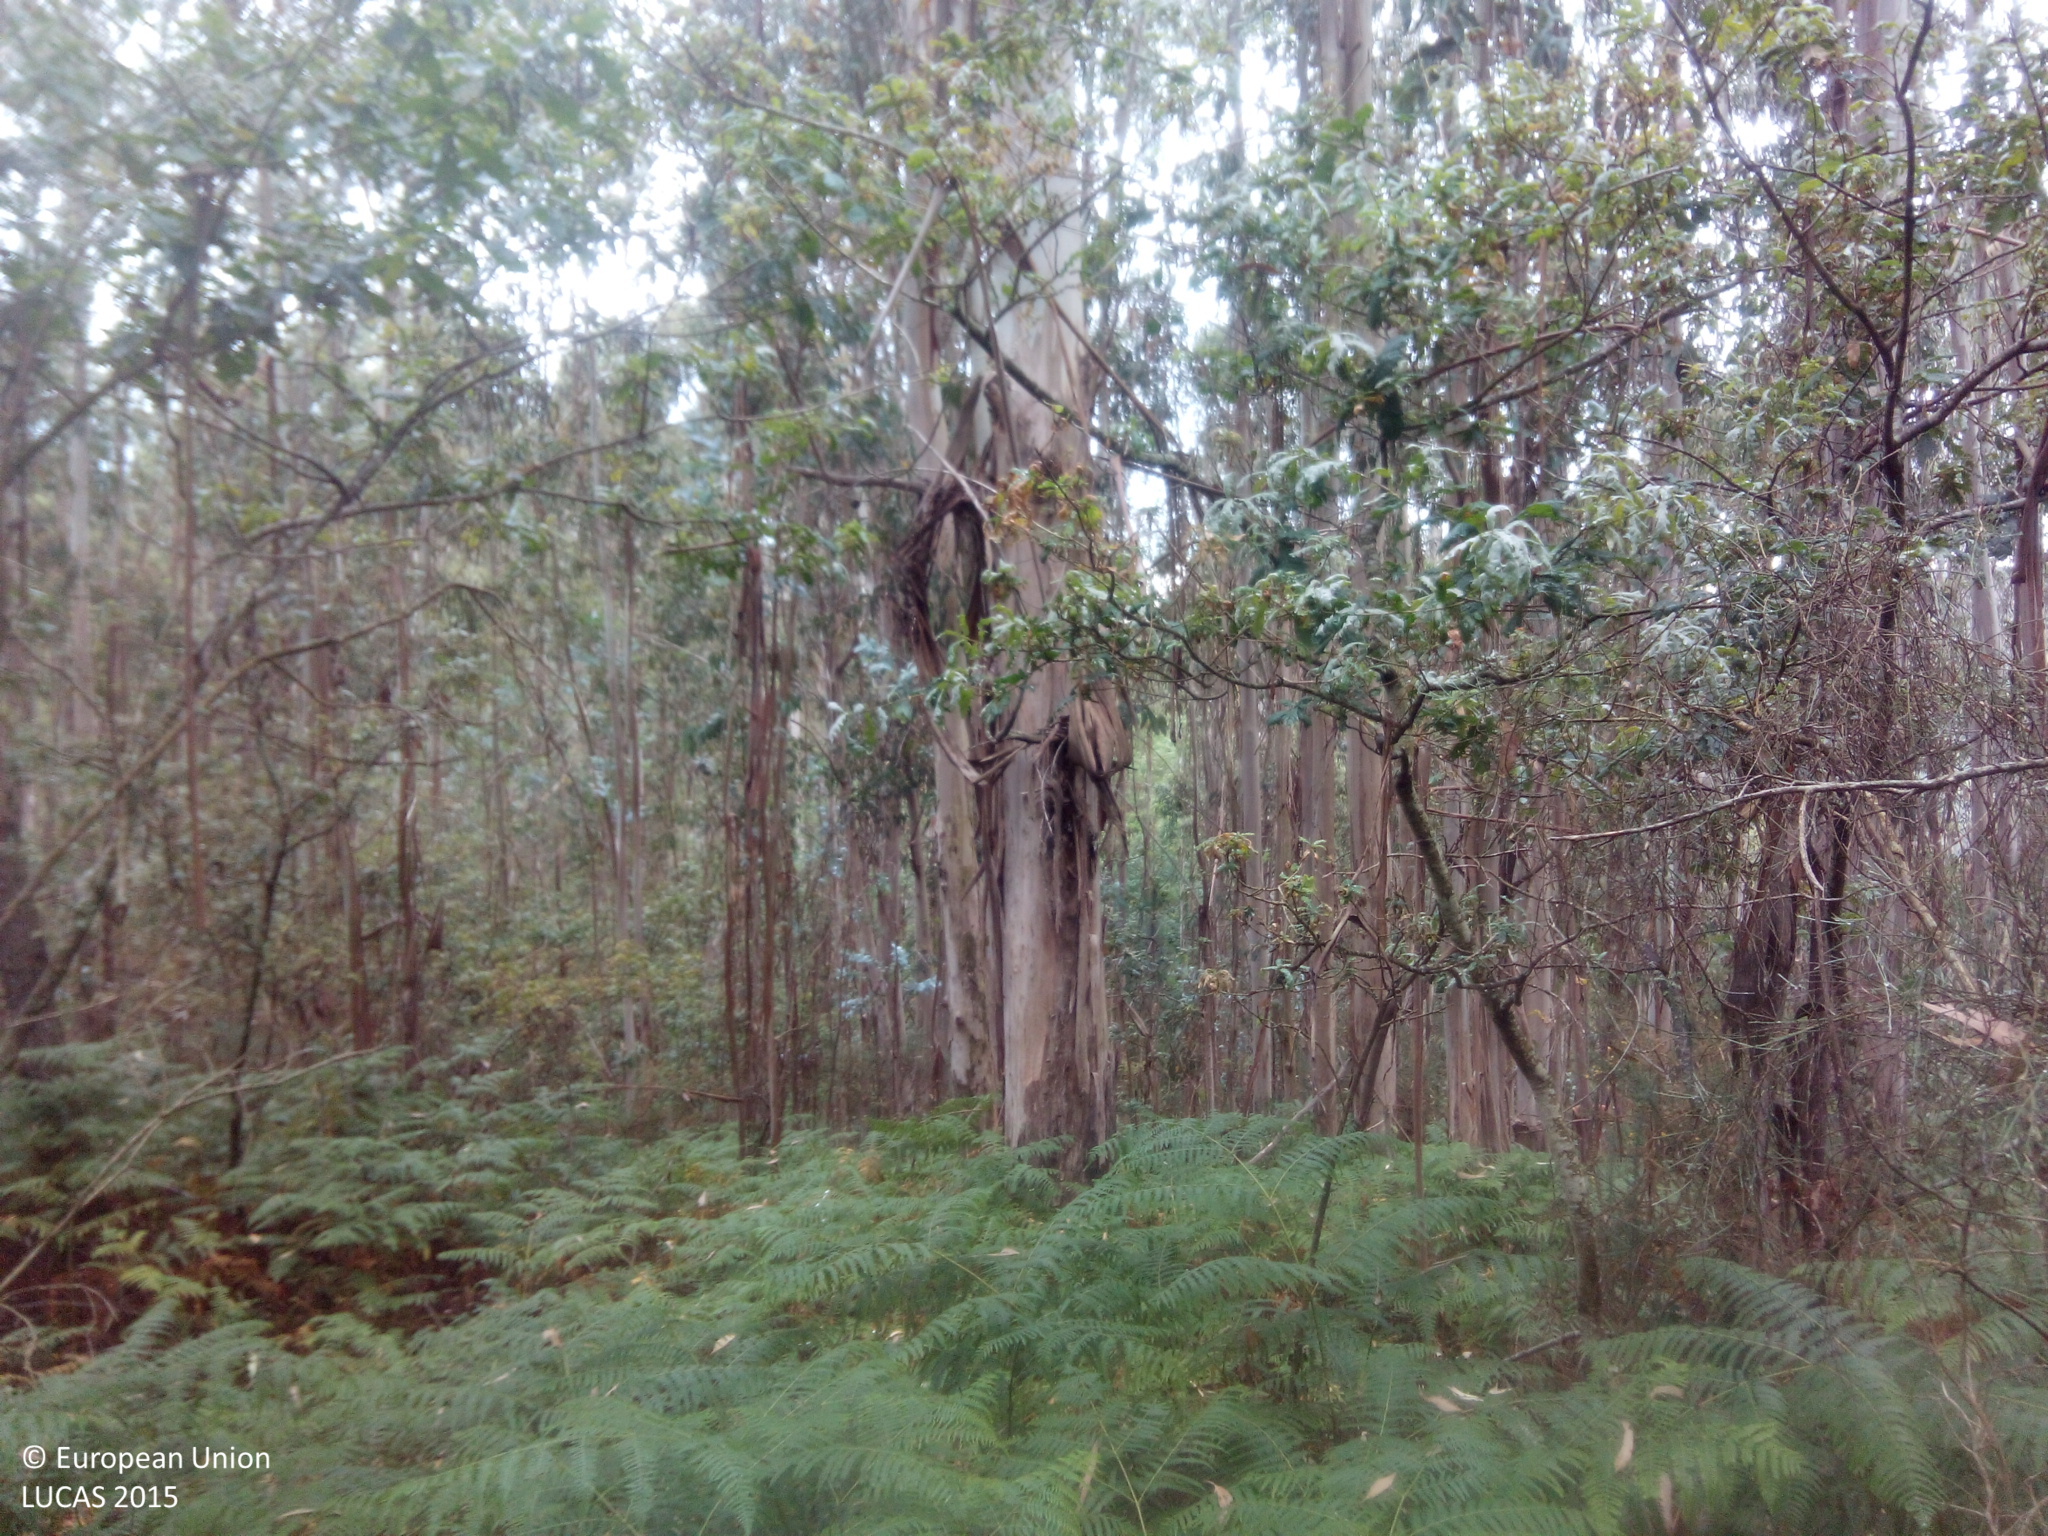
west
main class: Woodland
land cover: Broadleaved woodland
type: exotic forest
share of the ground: > 75 %
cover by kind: broadleaved forest trees 100 %
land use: Forestry
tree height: > 5 m
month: July
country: ES
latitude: 42.2742
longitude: -8.3382
